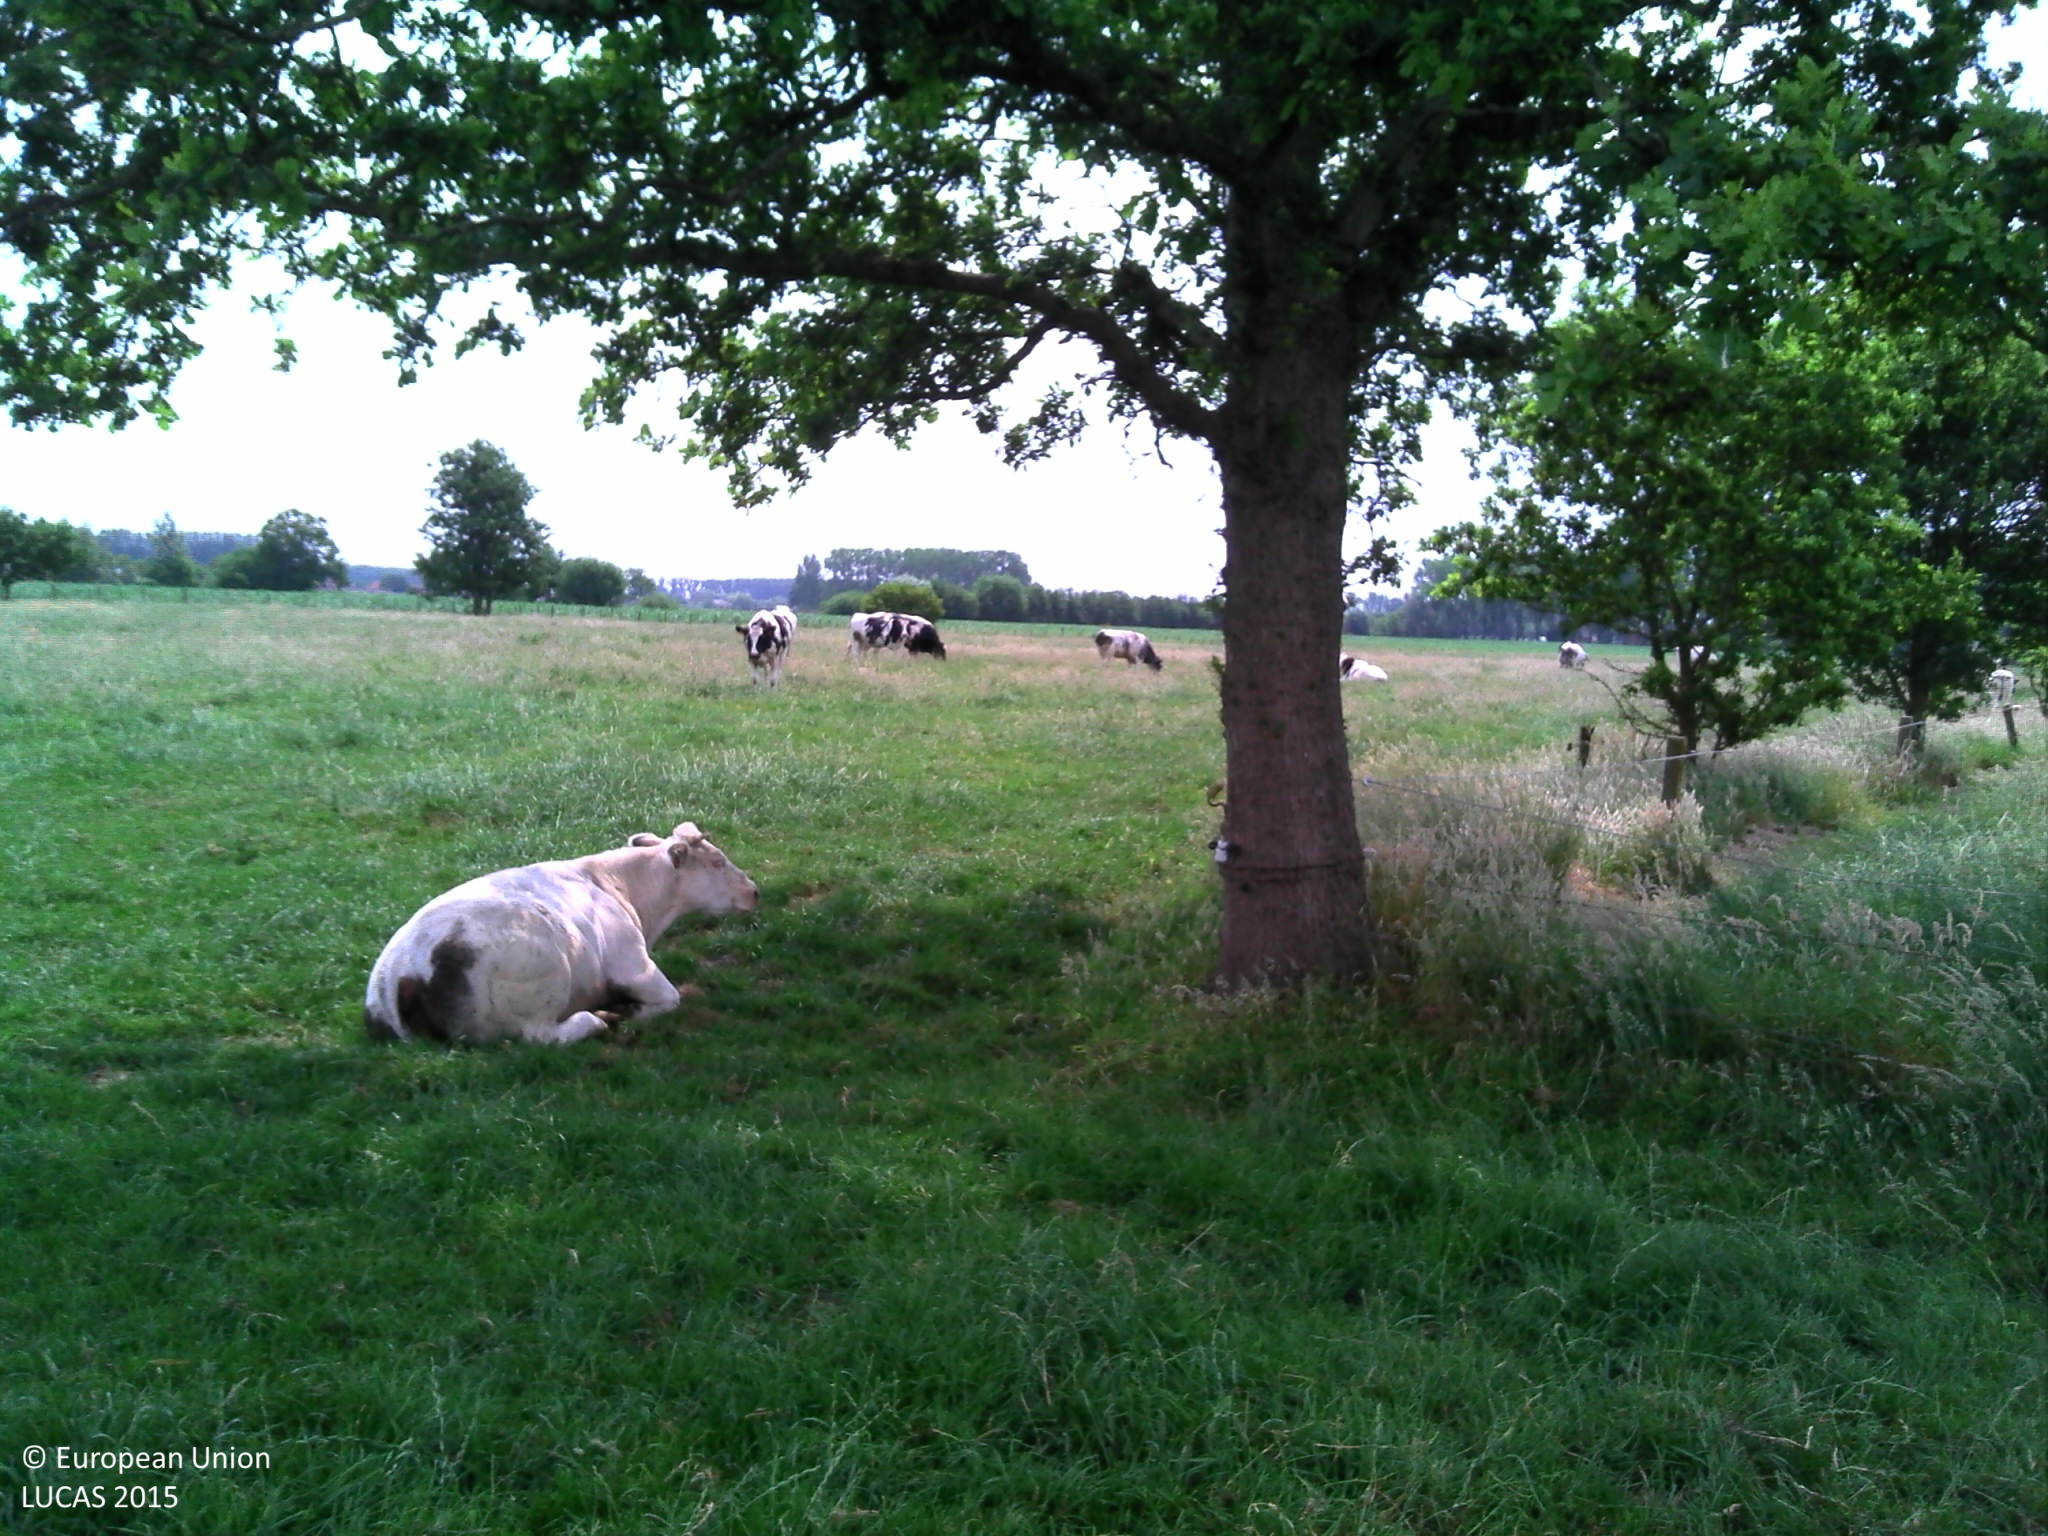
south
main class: Grassland
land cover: Grassland without tree/shrub cover
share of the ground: > 75 %
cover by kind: herbaceous plants 100 %
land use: Agriculture (excluding fallow land and kitchen gardens)
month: July
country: BE
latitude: 51.2289
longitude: 3.5625
